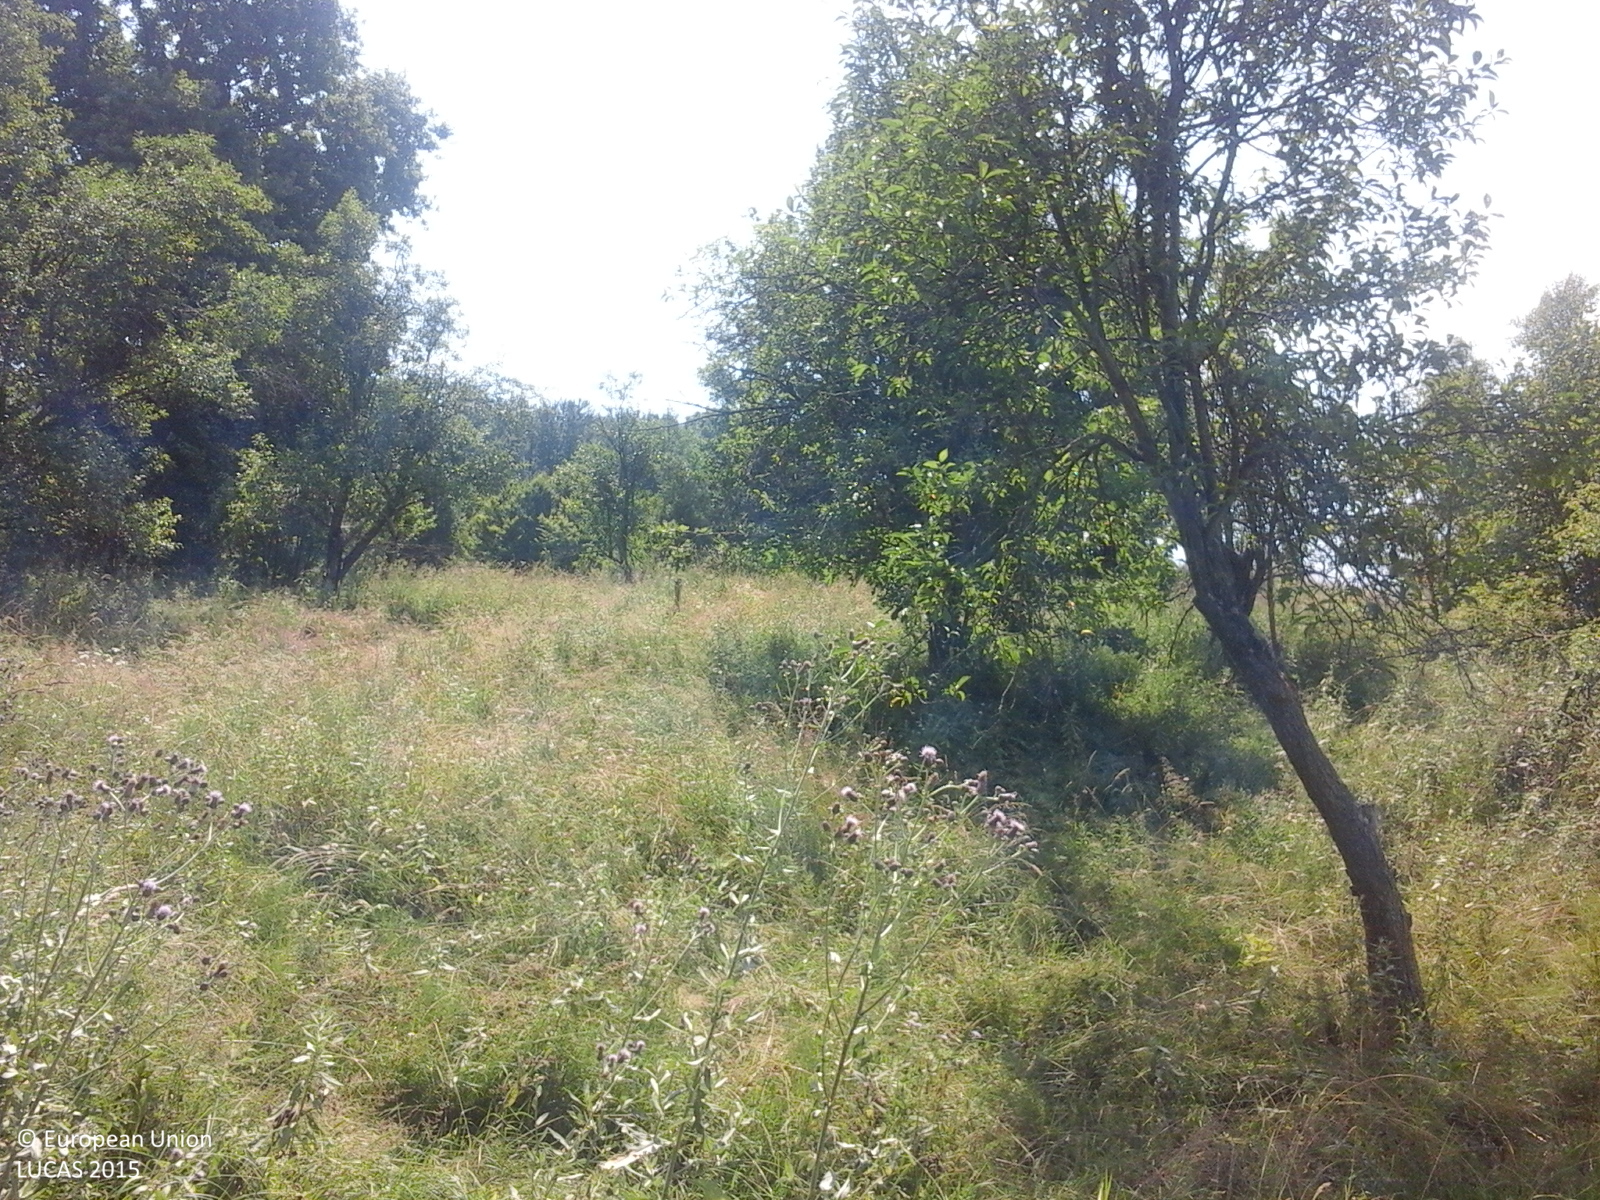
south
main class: Cropland
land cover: Other fruit trees and berries
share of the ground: 25 - 50 %
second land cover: Spontaneously vegetated surfaces
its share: > 75 %
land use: Agriculture (excluding fallow land and kitchen gardens)
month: July
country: RO
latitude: 45.0865
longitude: 24.4703
